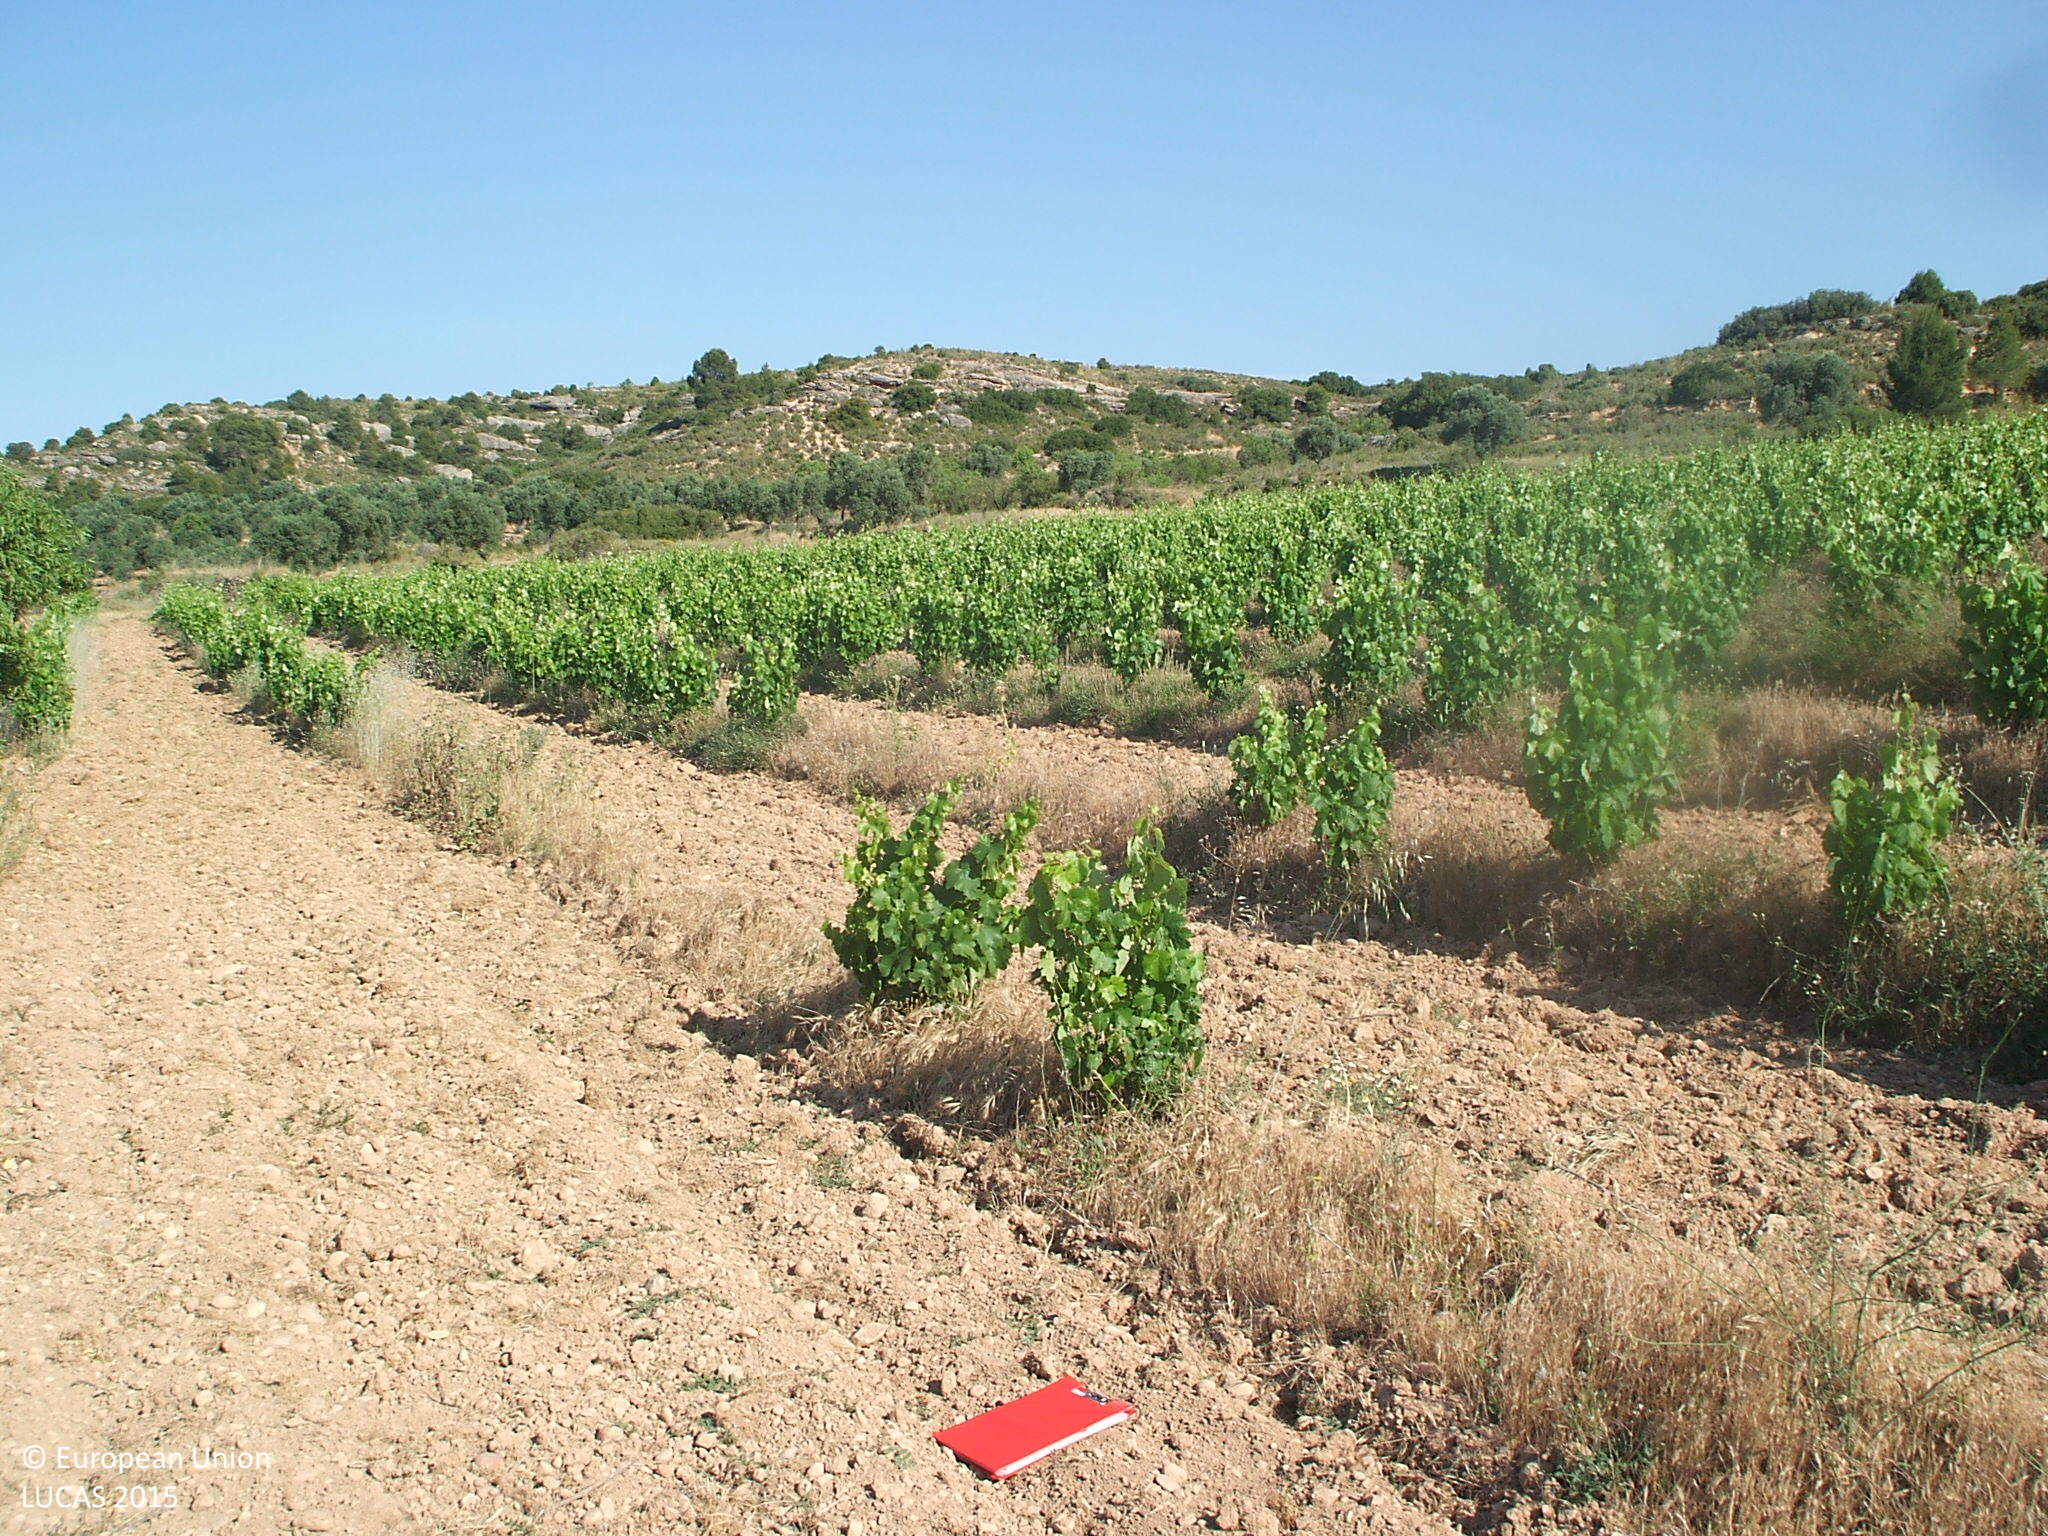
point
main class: Cropland
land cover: Vineyards
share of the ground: 10 - 25 %
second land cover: Other bare soil
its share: > 75 %
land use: Agriculture (excluding fallow land and kitchen gardens)
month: June
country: ES
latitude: 40.9808
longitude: -0.1249
